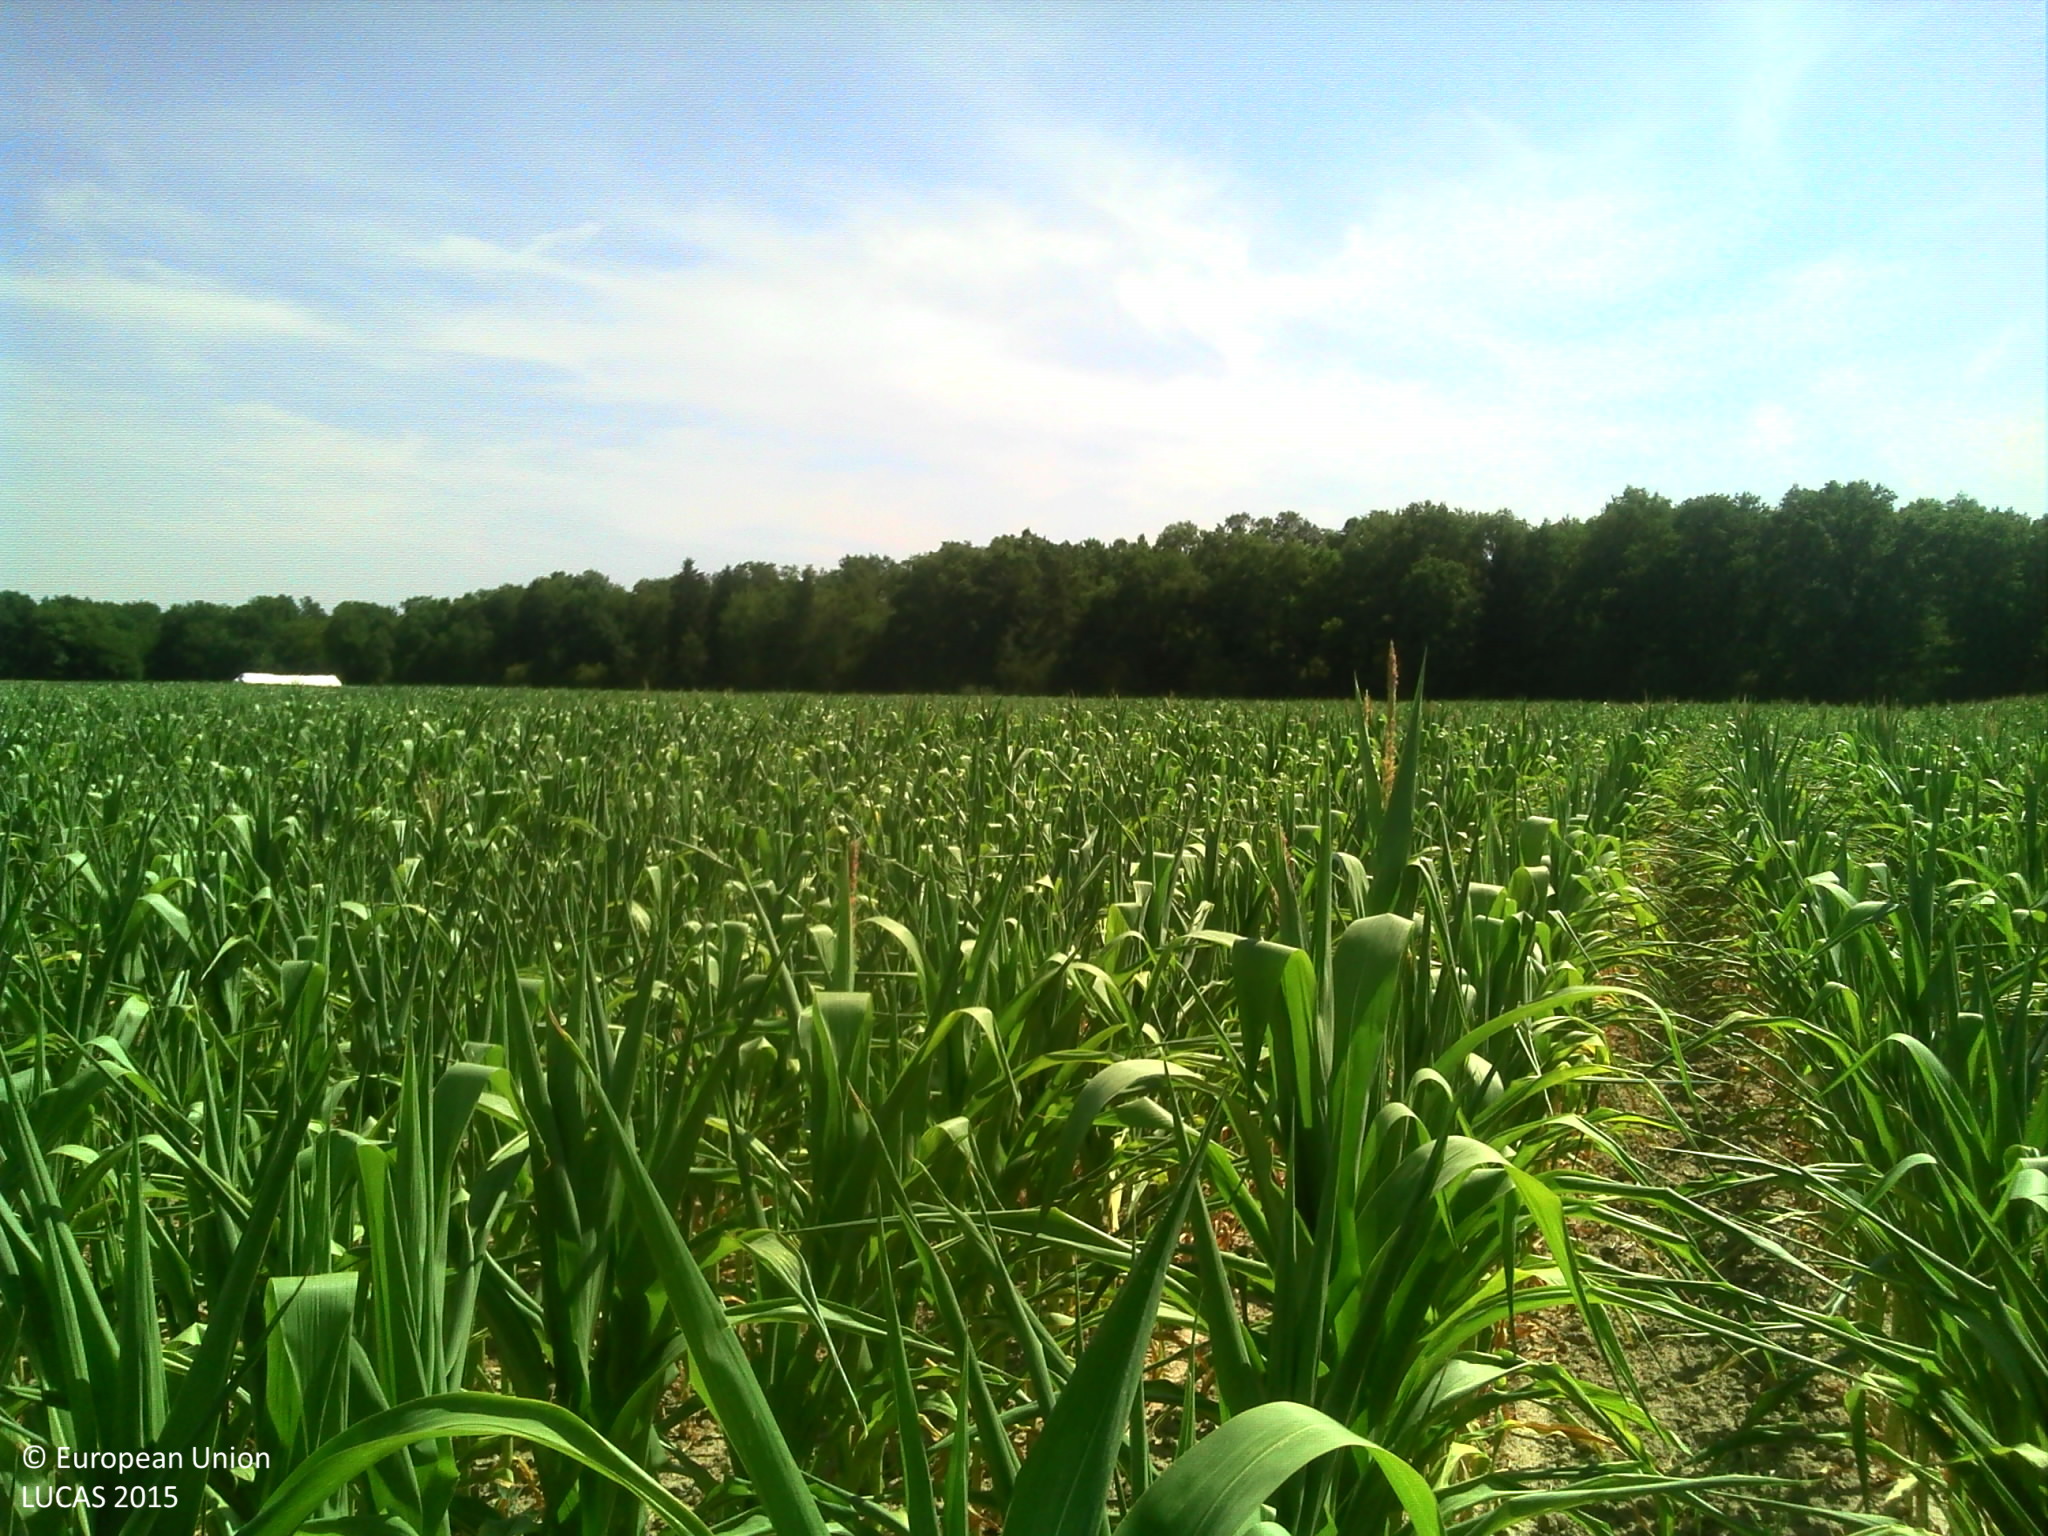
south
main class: Cropland
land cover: Maize
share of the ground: > 75 %
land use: Agriculture (excluding fallow land and kitchen gardens)
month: July
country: FR
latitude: 46.7270
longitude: 5.1212
